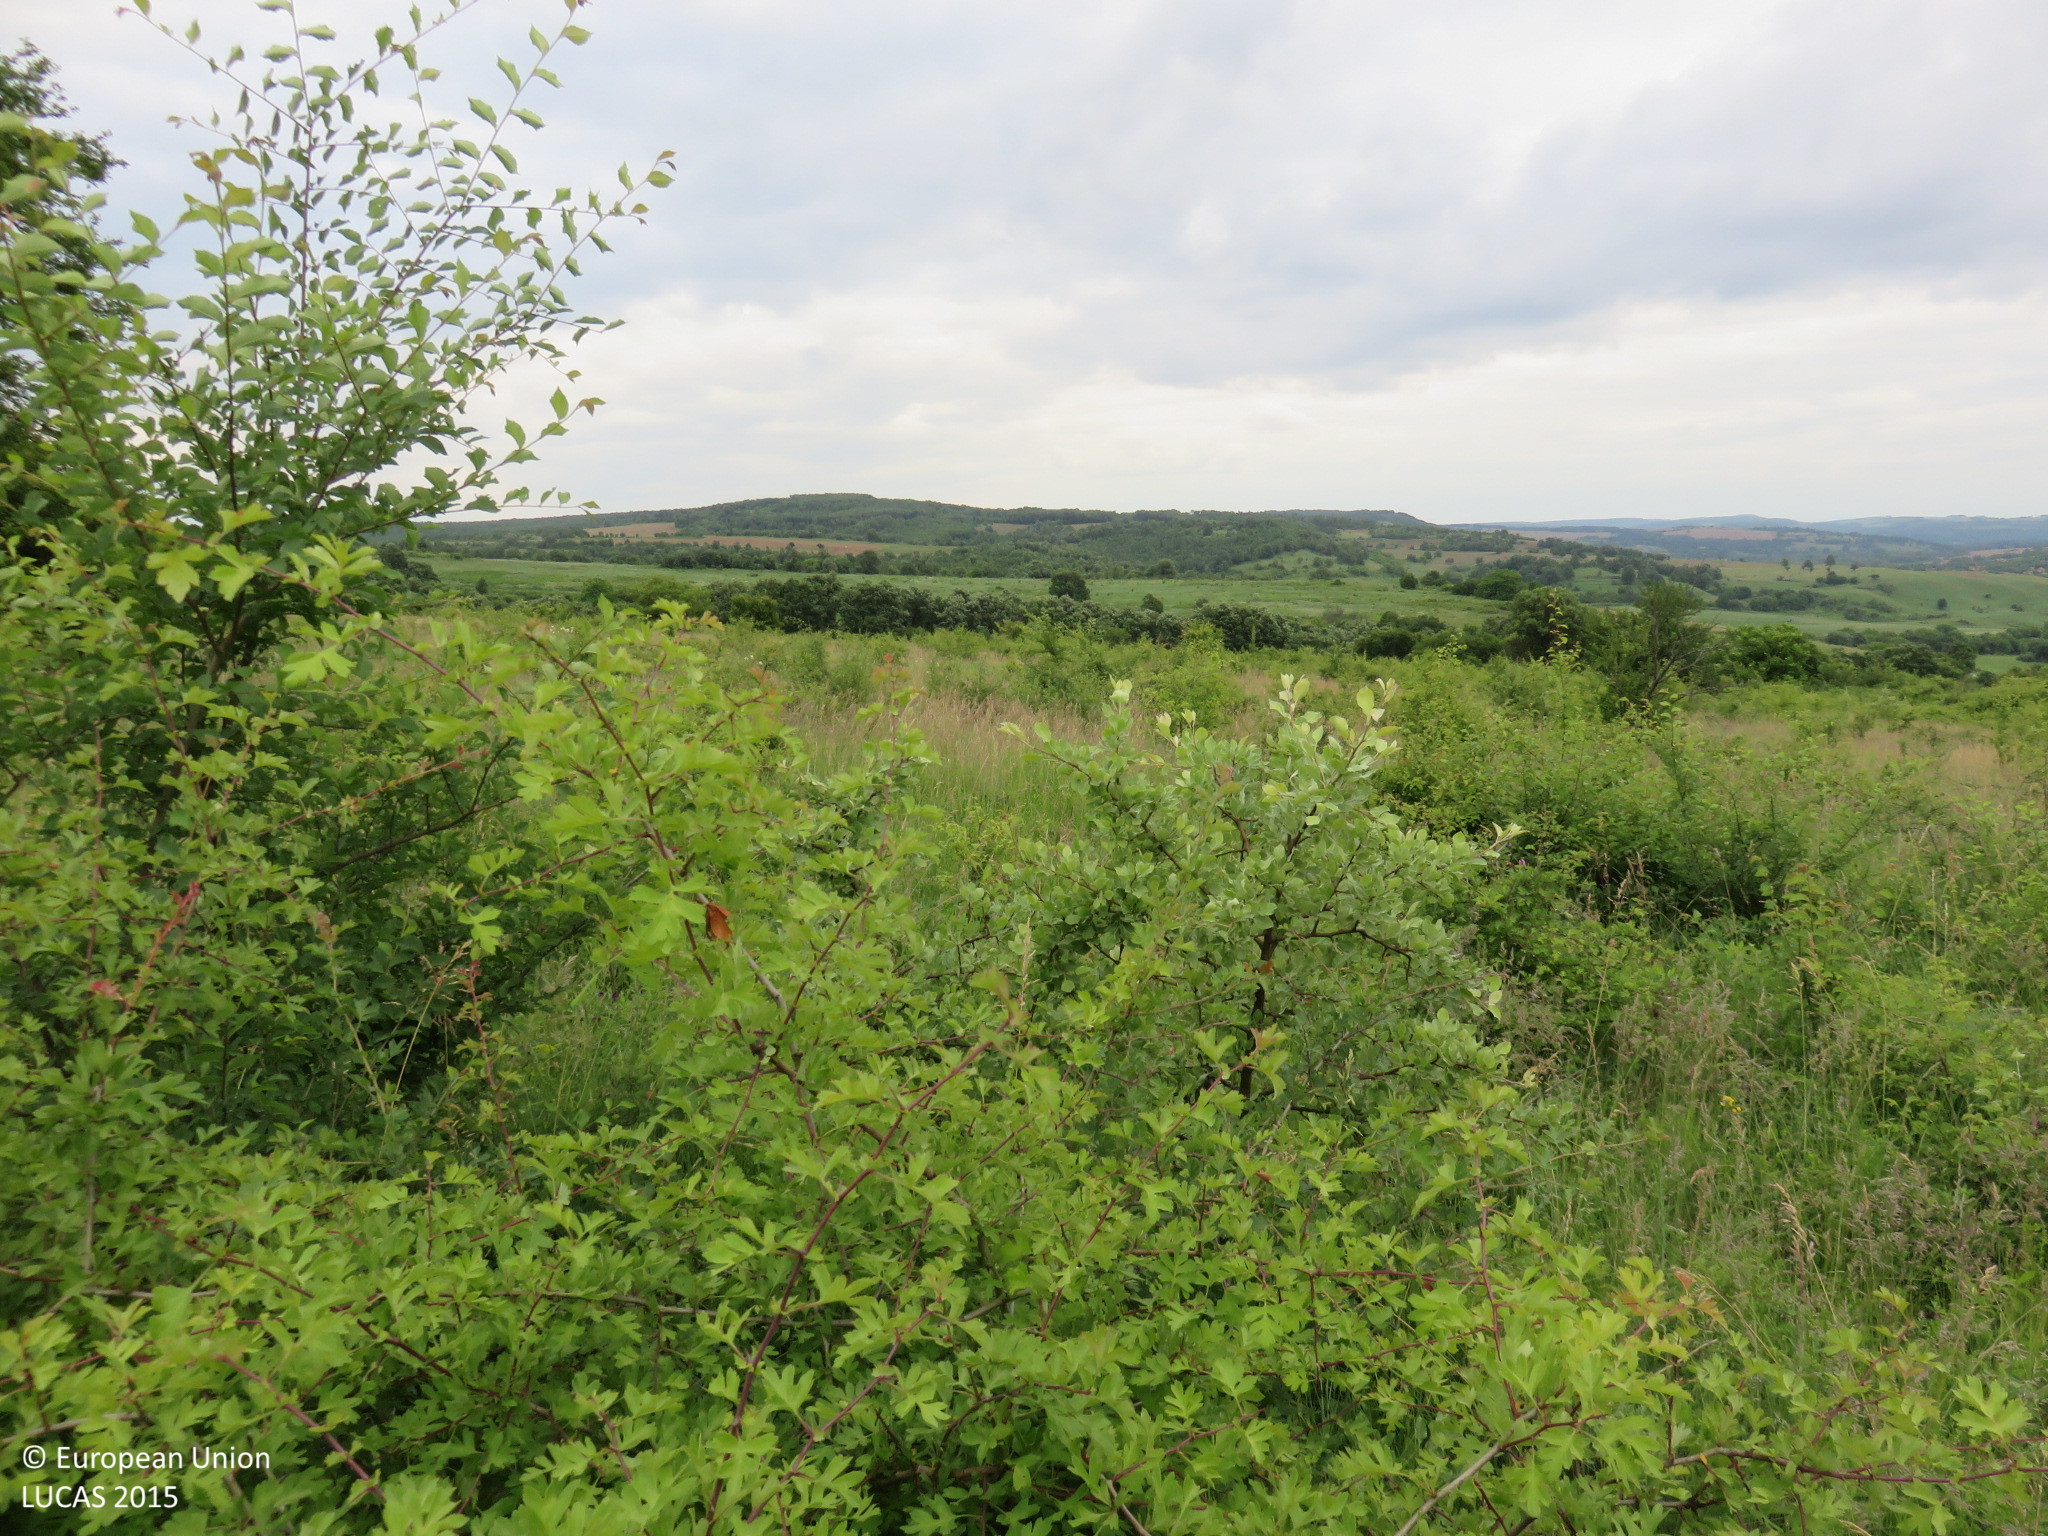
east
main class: Shrubland
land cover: Shrubland without tree cover
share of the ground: > 75 %
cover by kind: shrubs 85 %, herbaceous plants 15 %
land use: Fallow land
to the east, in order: Shrubland without tree cover; Grassland with sparse tree/shrub cover; Grassland without tree/shrub cover; Single bushes/trees; Grassland without tree/shrub cover
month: May
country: BG
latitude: 43.2196
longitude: 24.4741
